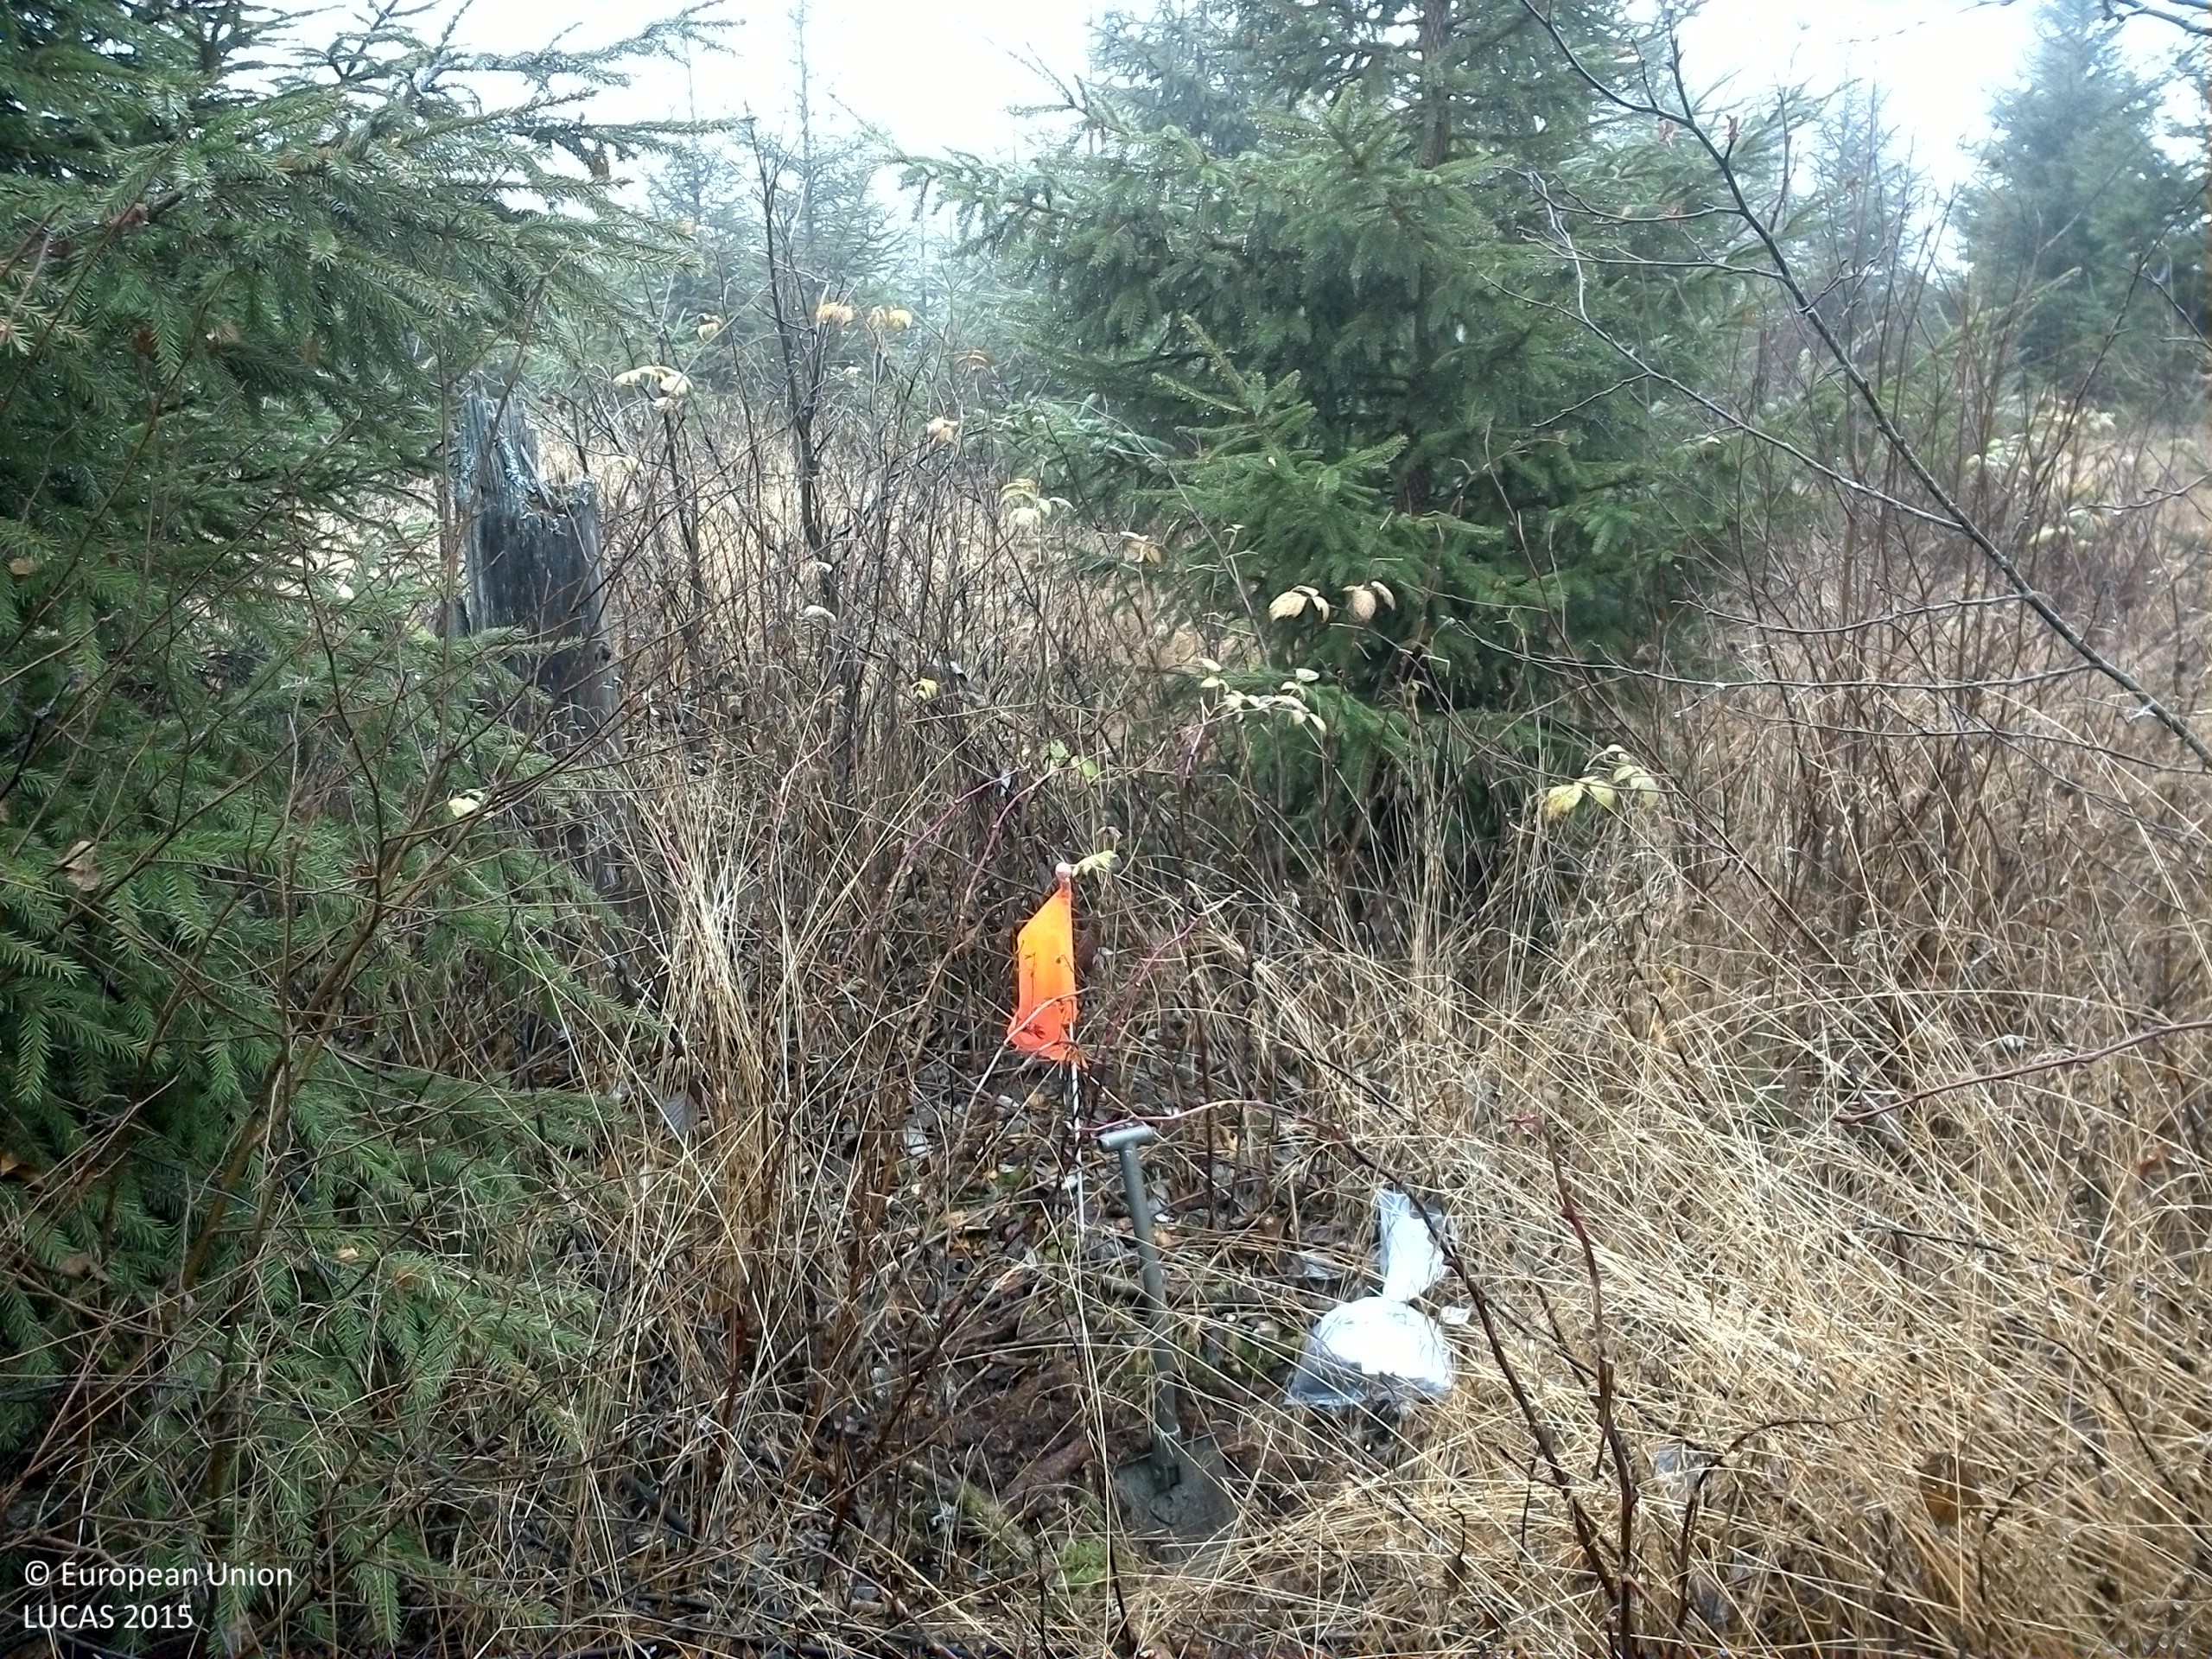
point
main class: Woodland
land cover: Spruce dominated mixed woodland
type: boreal forest
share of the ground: 50 - 75 %
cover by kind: coniferous forest trees 45 %, broadleaved forest trees 25 %, shrubs 15 %, herbaceous plants 15 %
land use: Forestry
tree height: < 5 m
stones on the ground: < 10 %
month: November
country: SE
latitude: 57.9150
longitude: 14.8731
